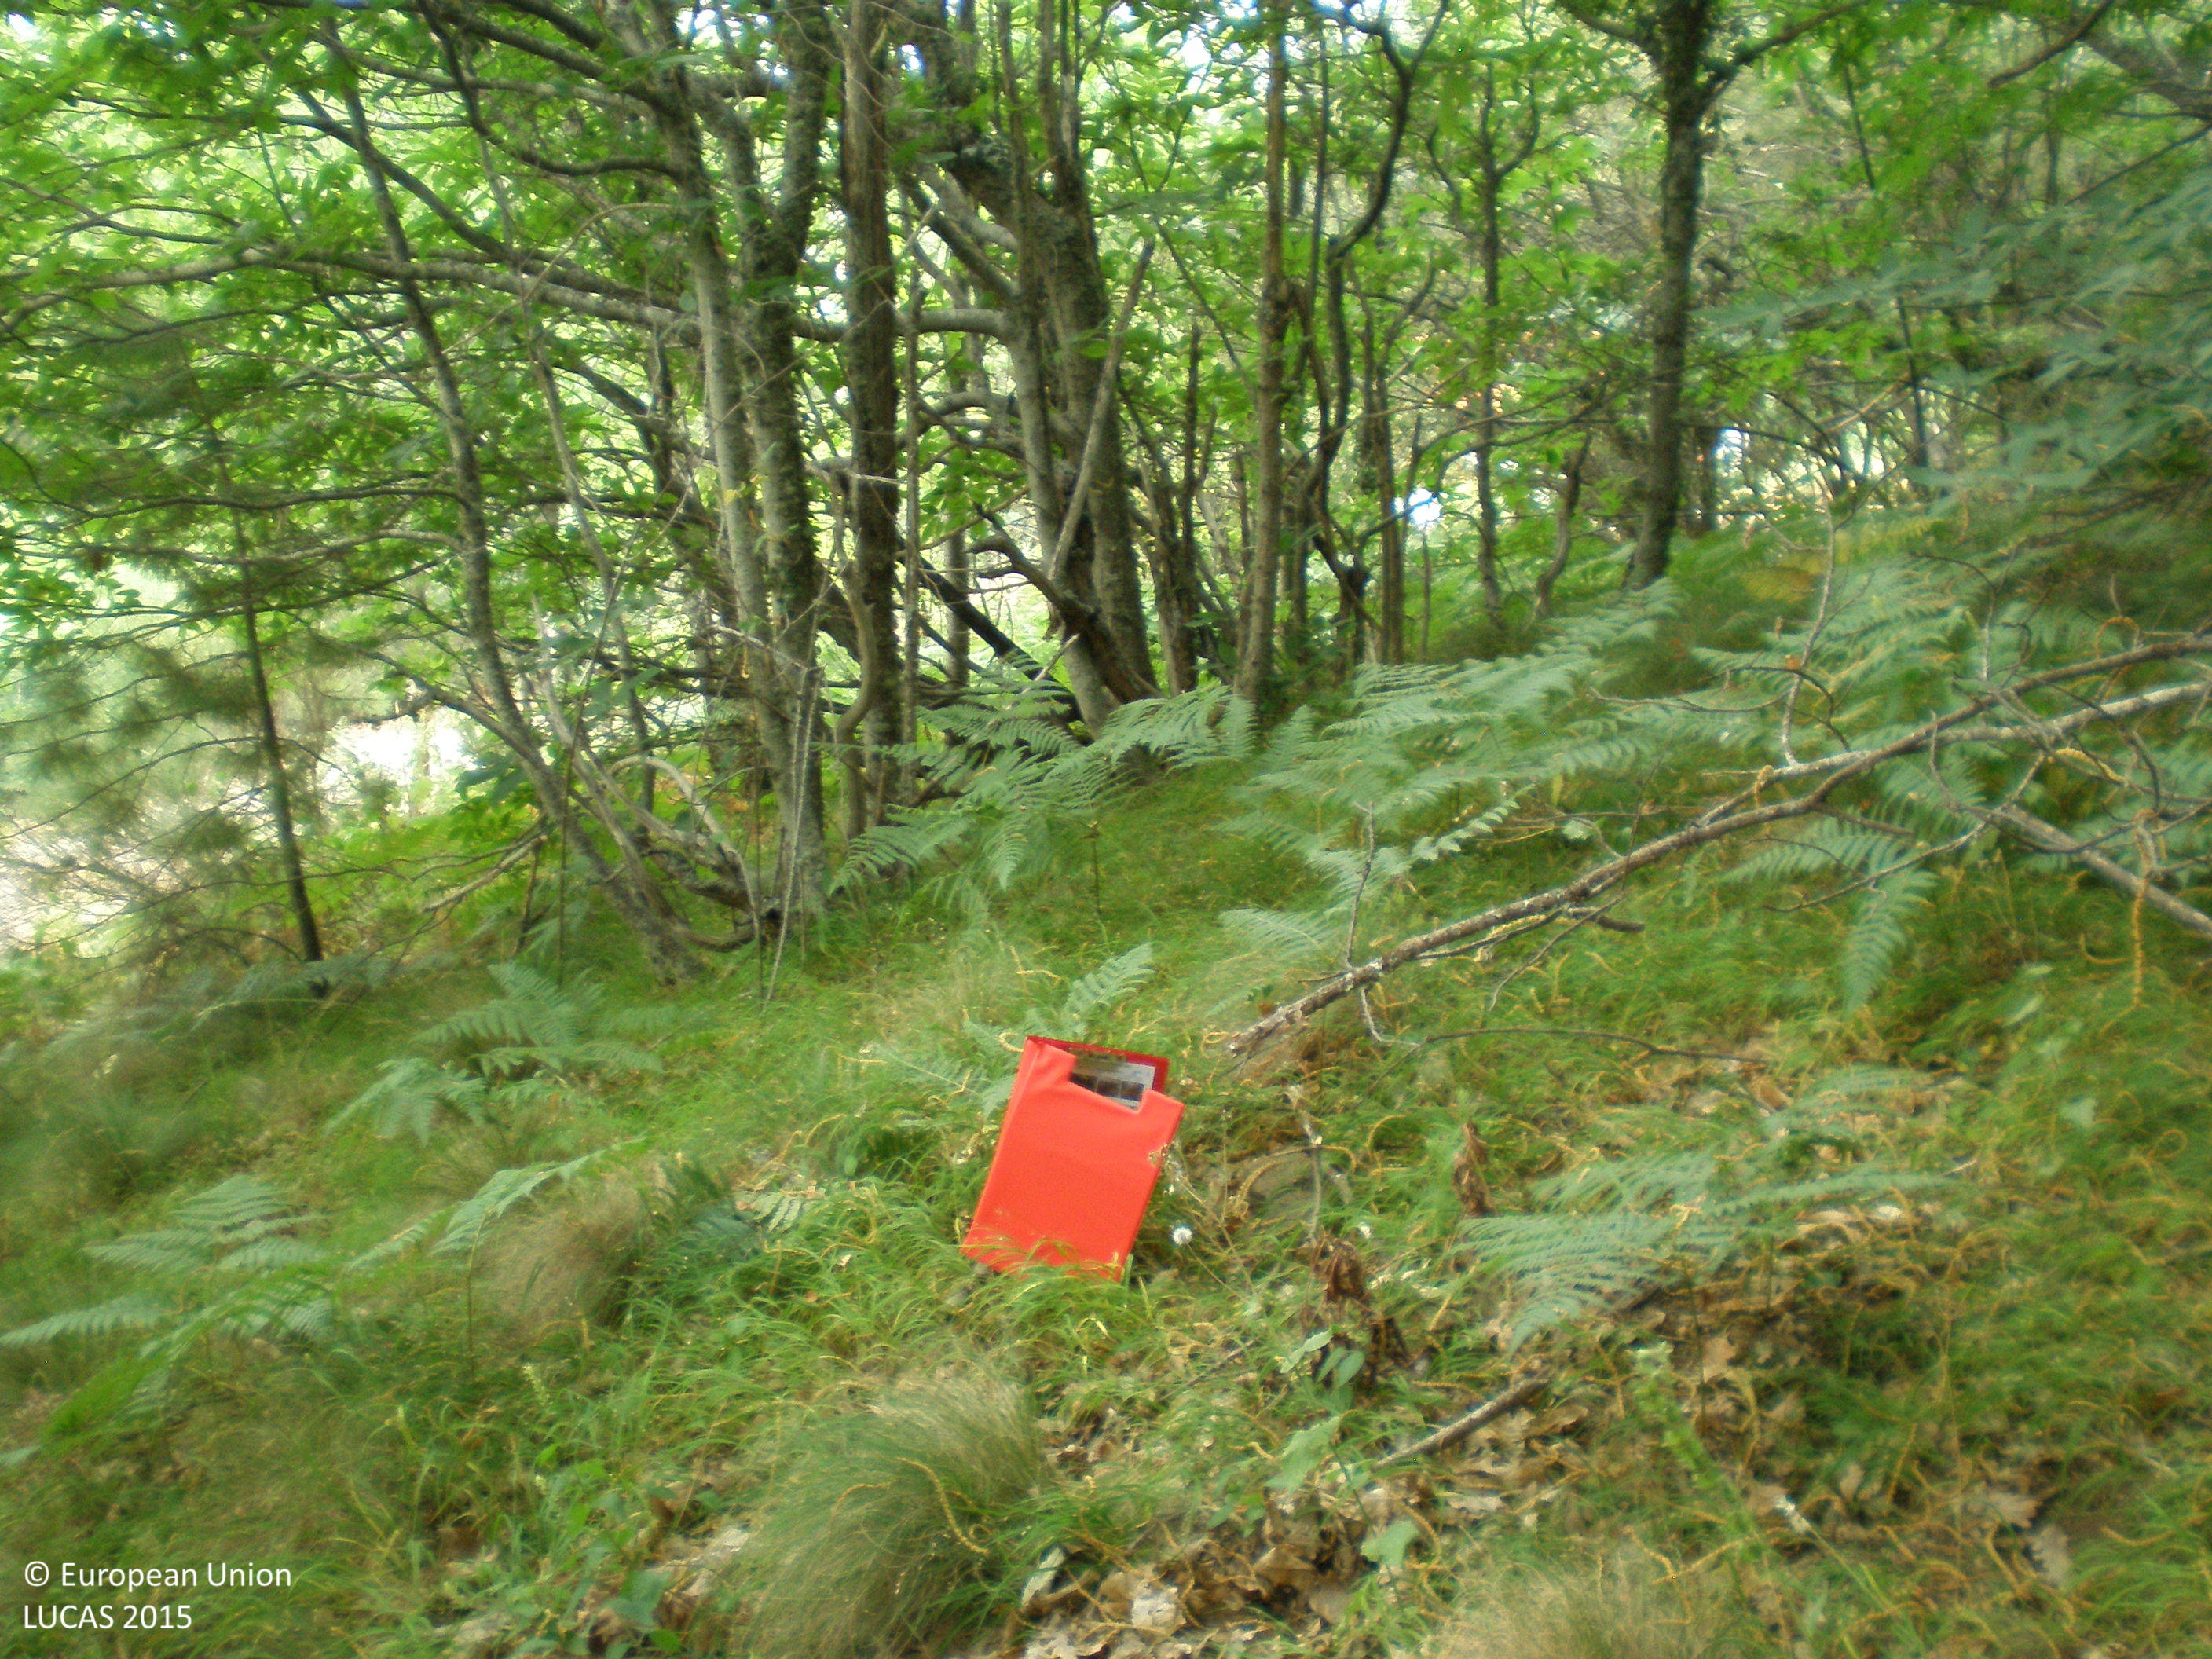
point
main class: Woodland
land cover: Broadleaved woodland
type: thermophilous deciduous forest
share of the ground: > 75 %
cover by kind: broadleaved forest trees 100 %
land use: Forestry
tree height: > 5 m
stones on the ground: < 10 %
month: July
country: ES
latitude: 40.3802
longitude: -5.7719
